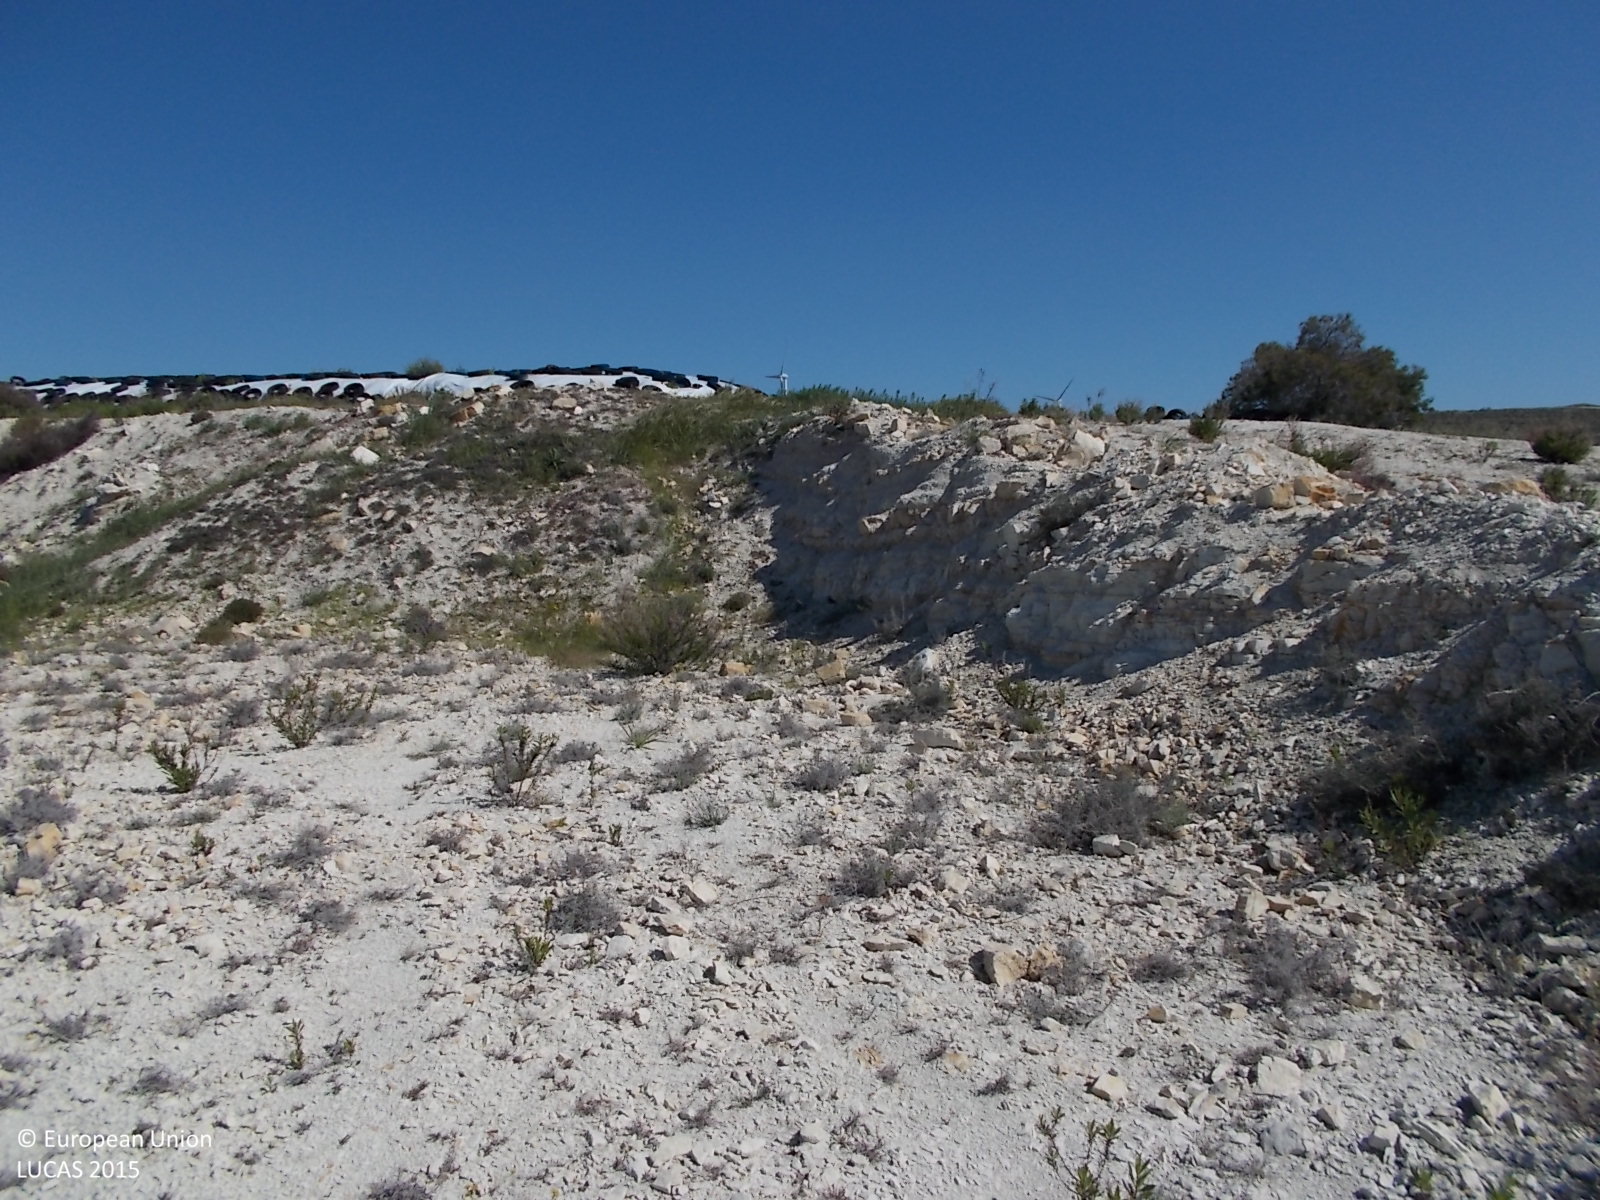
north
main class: Shrubland
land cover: Shrubland without tree cover
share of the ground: 10 - 25 %
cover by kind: unconsolidated bare surface 85 %, shrubs 10 %, herbaceous plants 5 %
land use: Abandoned areas
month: April
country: CY
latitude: 34.8479
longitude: 33.5171
